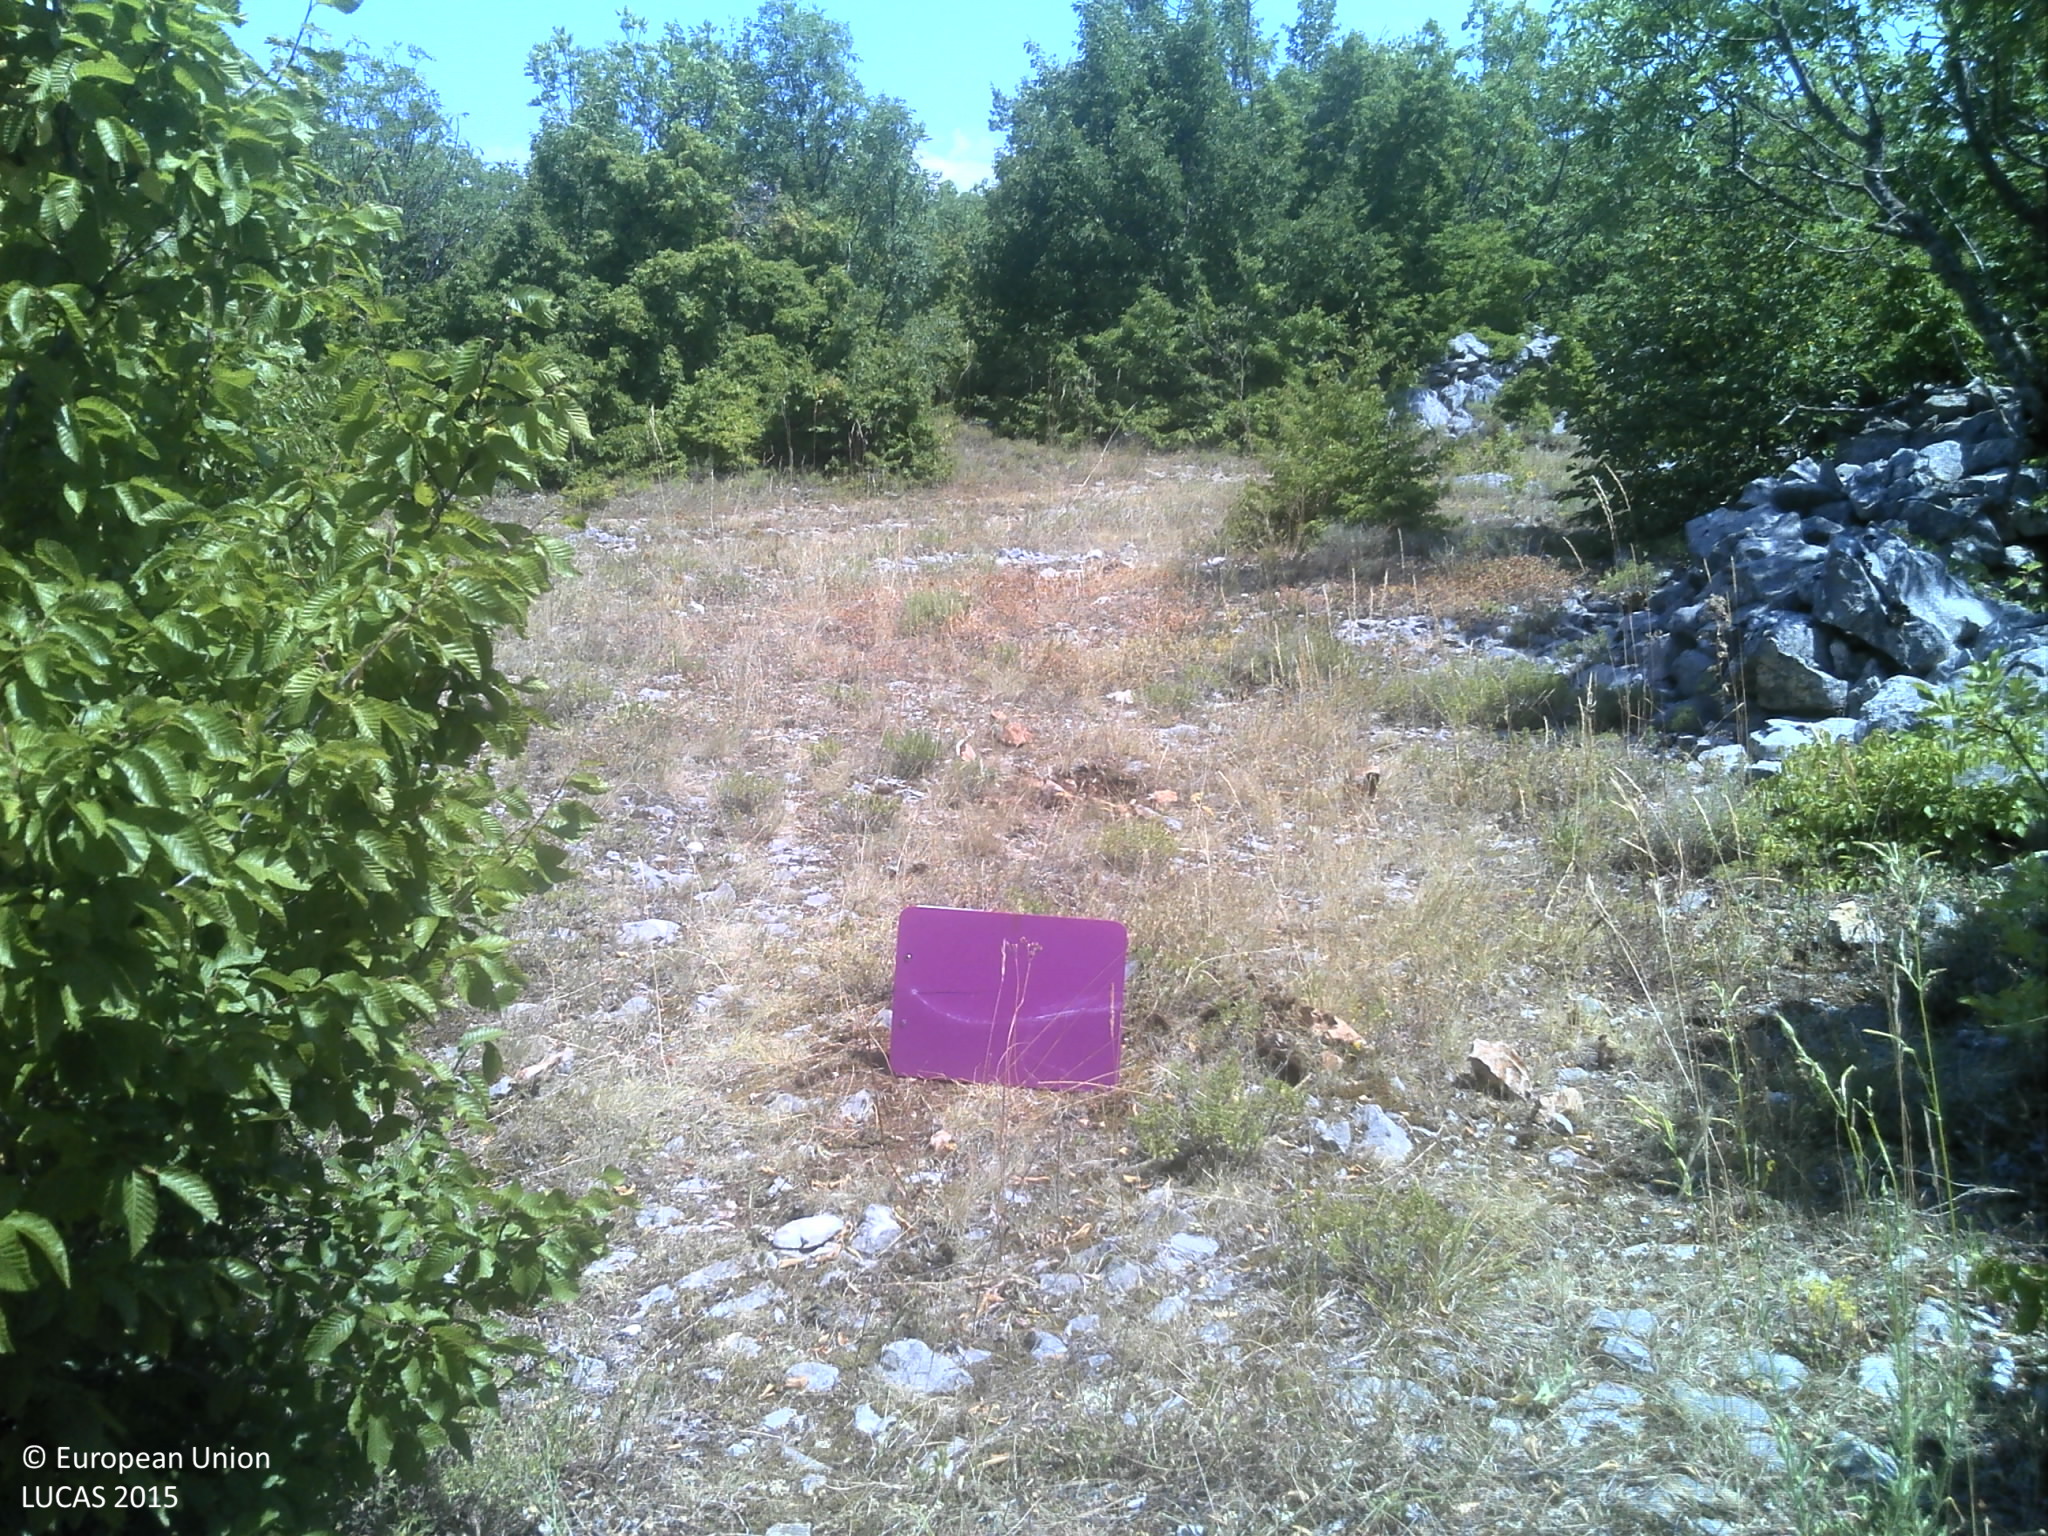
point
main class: Shrubland
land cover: Shrubland with sparse tree cover
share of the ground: > 75 %
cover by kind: shrubs 70 %, herbaceous plants 15 %, broadleaved forest trees 5 %, consolidated bare surface 5 %, unconsolidated bare surface 5 %
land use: Semi-natural and natural areas not in use
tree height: > 5 m
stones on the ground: < 10 %
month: July
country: HR
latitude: 43.4949
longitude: 17.0530
